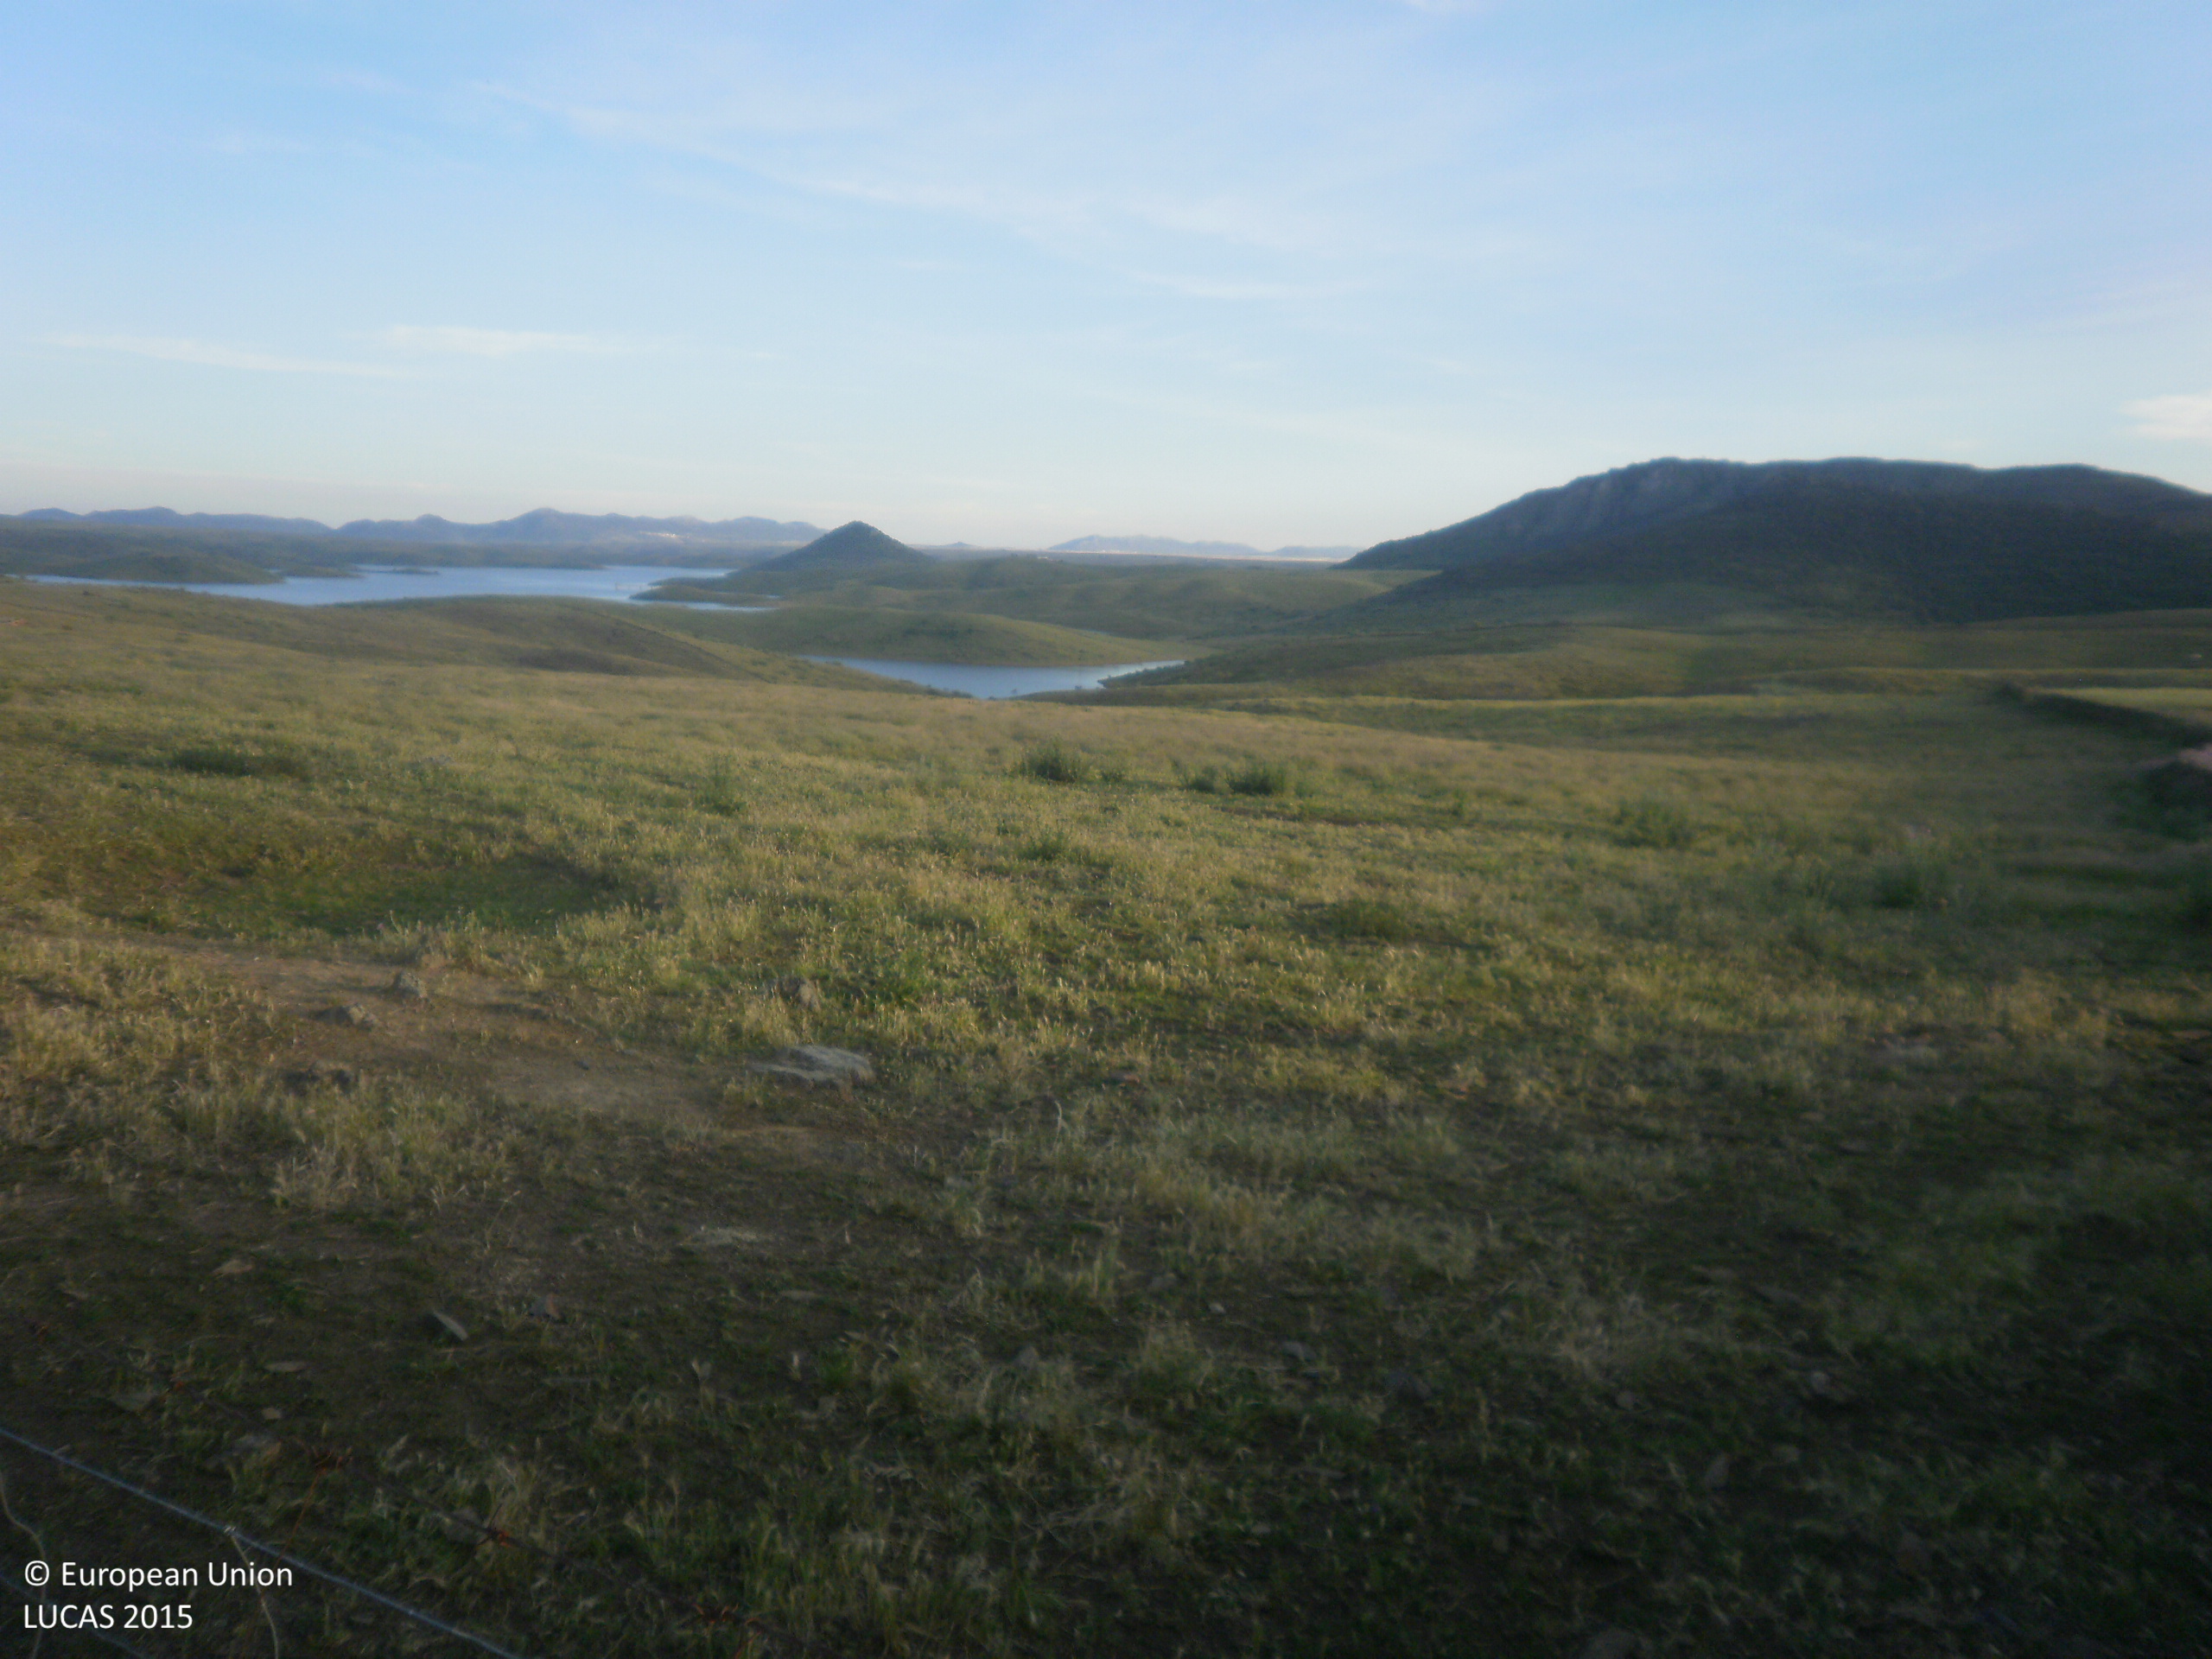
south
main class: Grassland
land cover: Grassland without tree/shrub cover
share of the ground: > 75 %
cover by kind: herbaceous plants 100 %
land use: Agriculture (excluding fallow land and kitchen gardens)
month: April
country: ES
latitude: 38.9804
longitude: -5.2185
